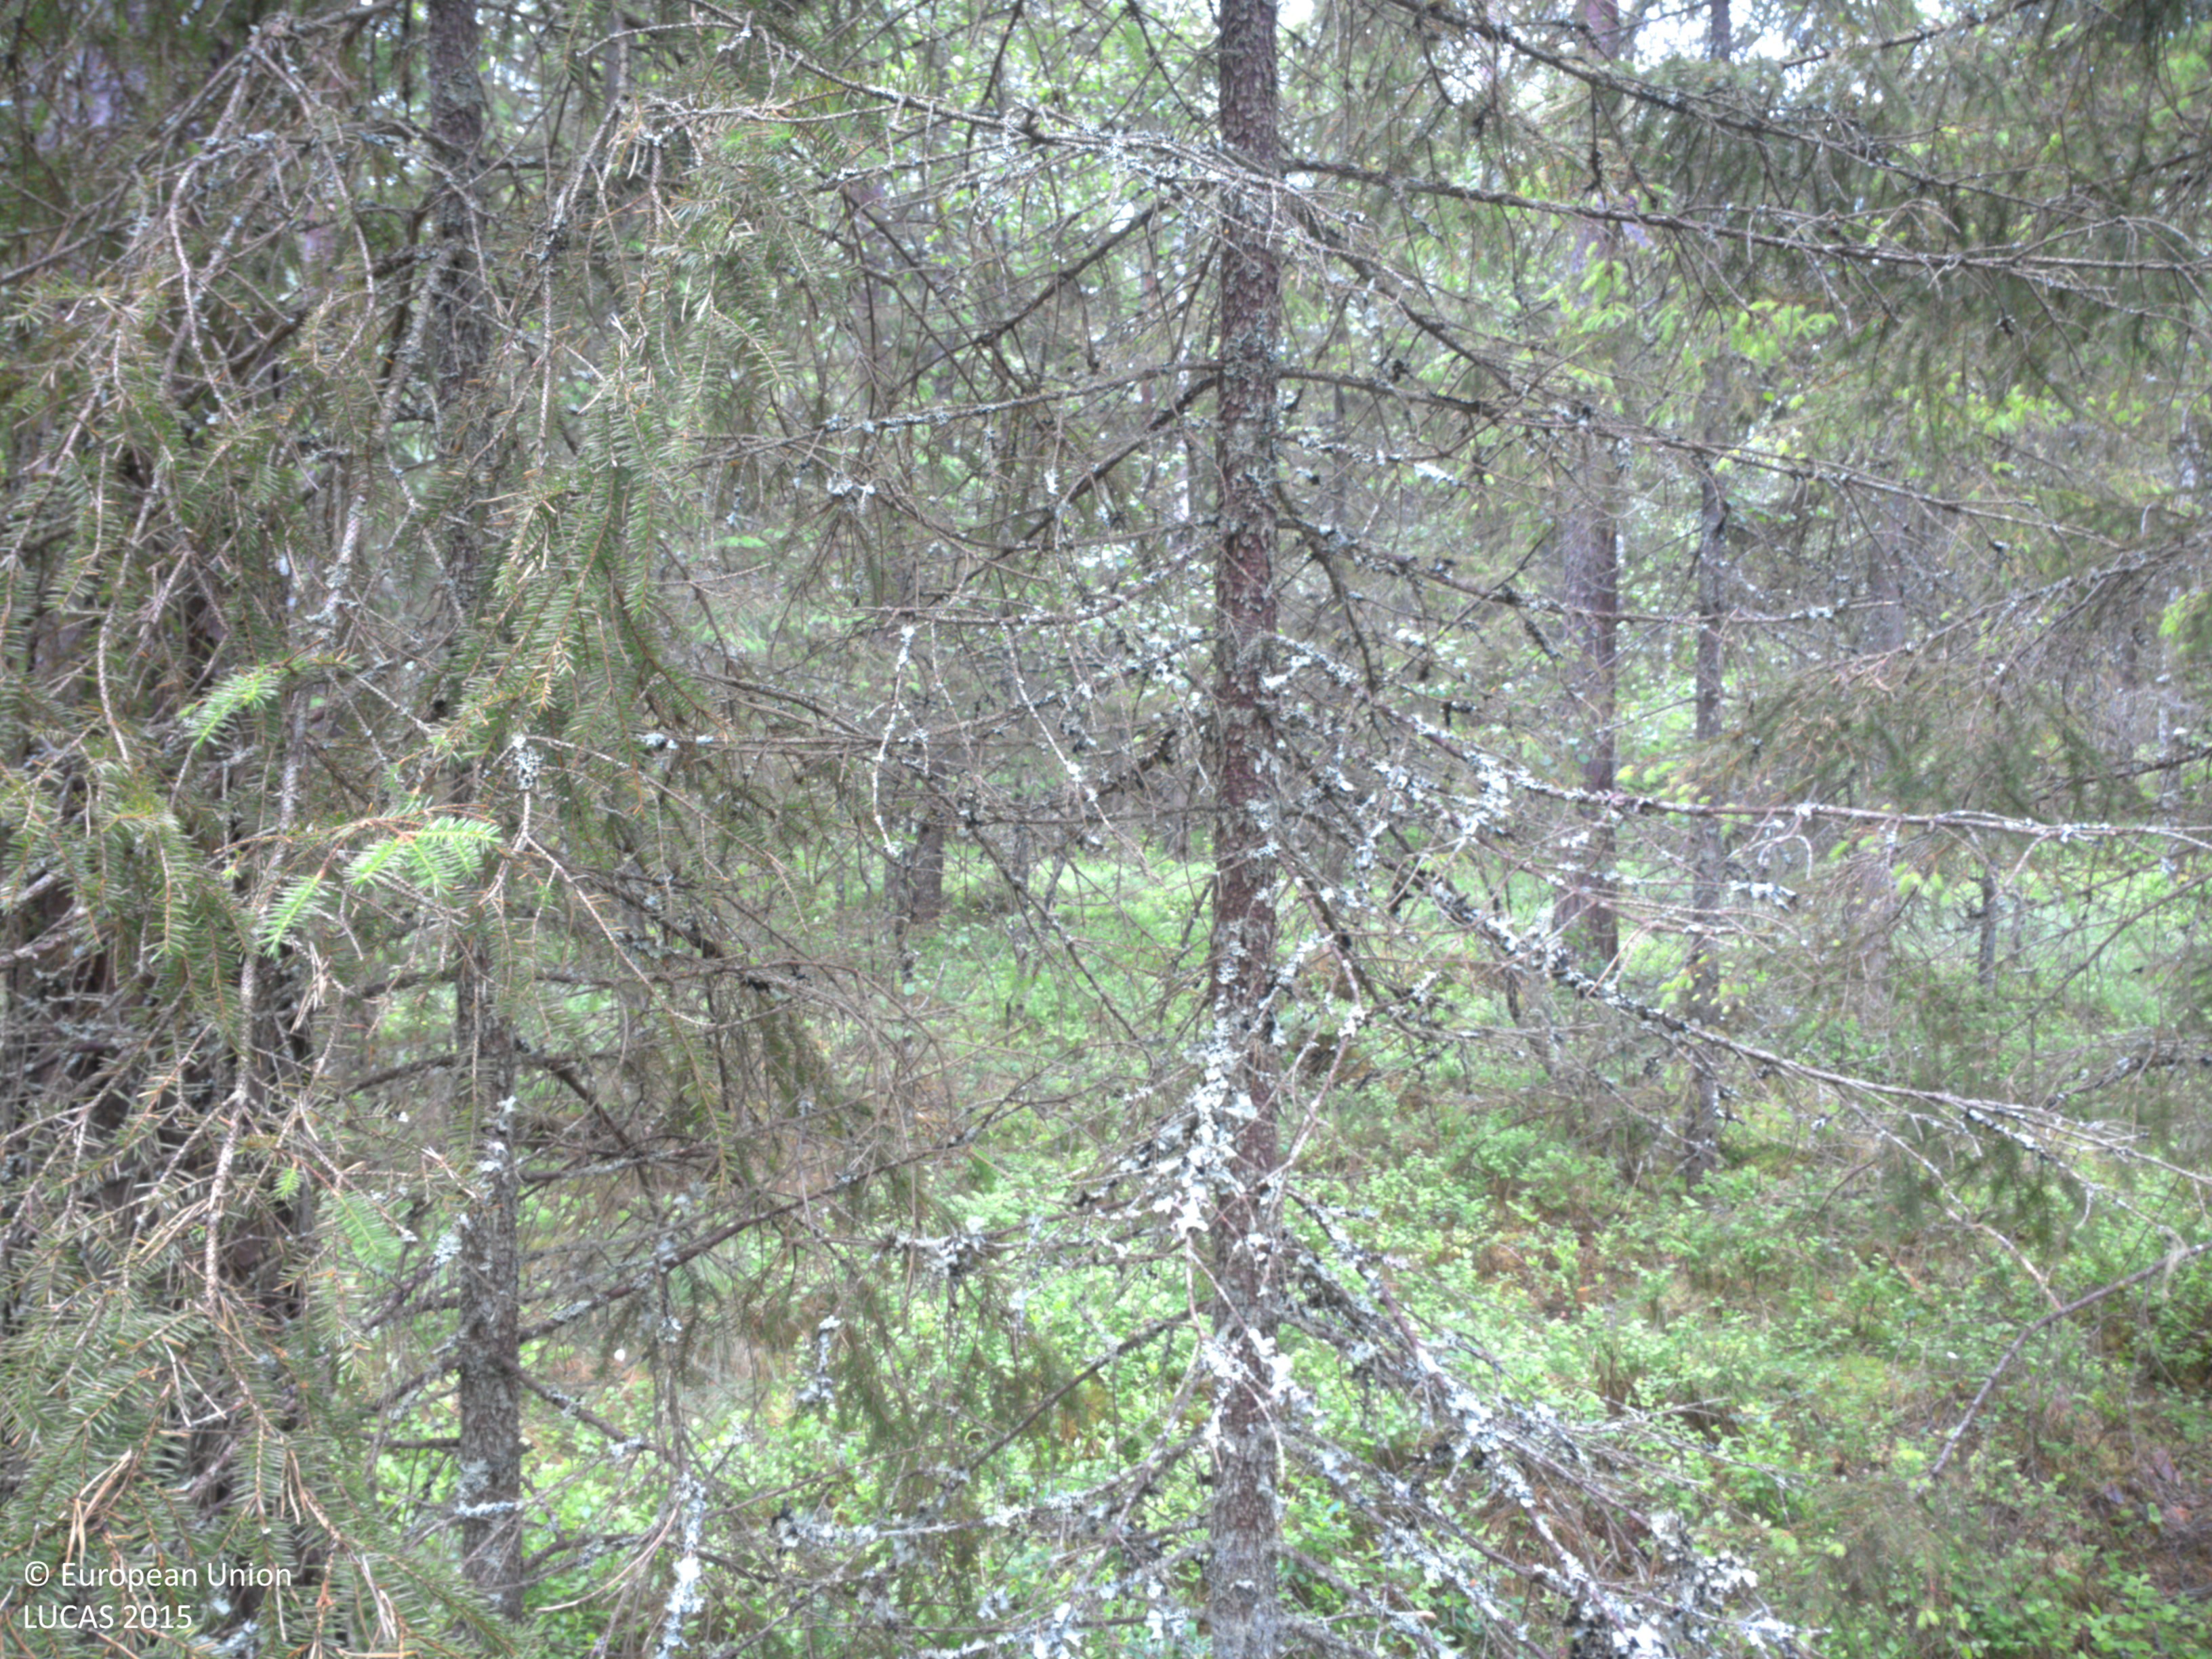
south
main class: Woodland
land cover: Spruce dominated coniferous woodland
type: boreal forest
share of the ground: 50 - 75 %
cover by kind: coniferous forest trees 50 %, lichens and mosses 40 %, herbaceous plants 10 %
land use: Forestry
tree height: > 5 m
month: June
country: SE
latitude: 58.9419
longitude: 12.0286
